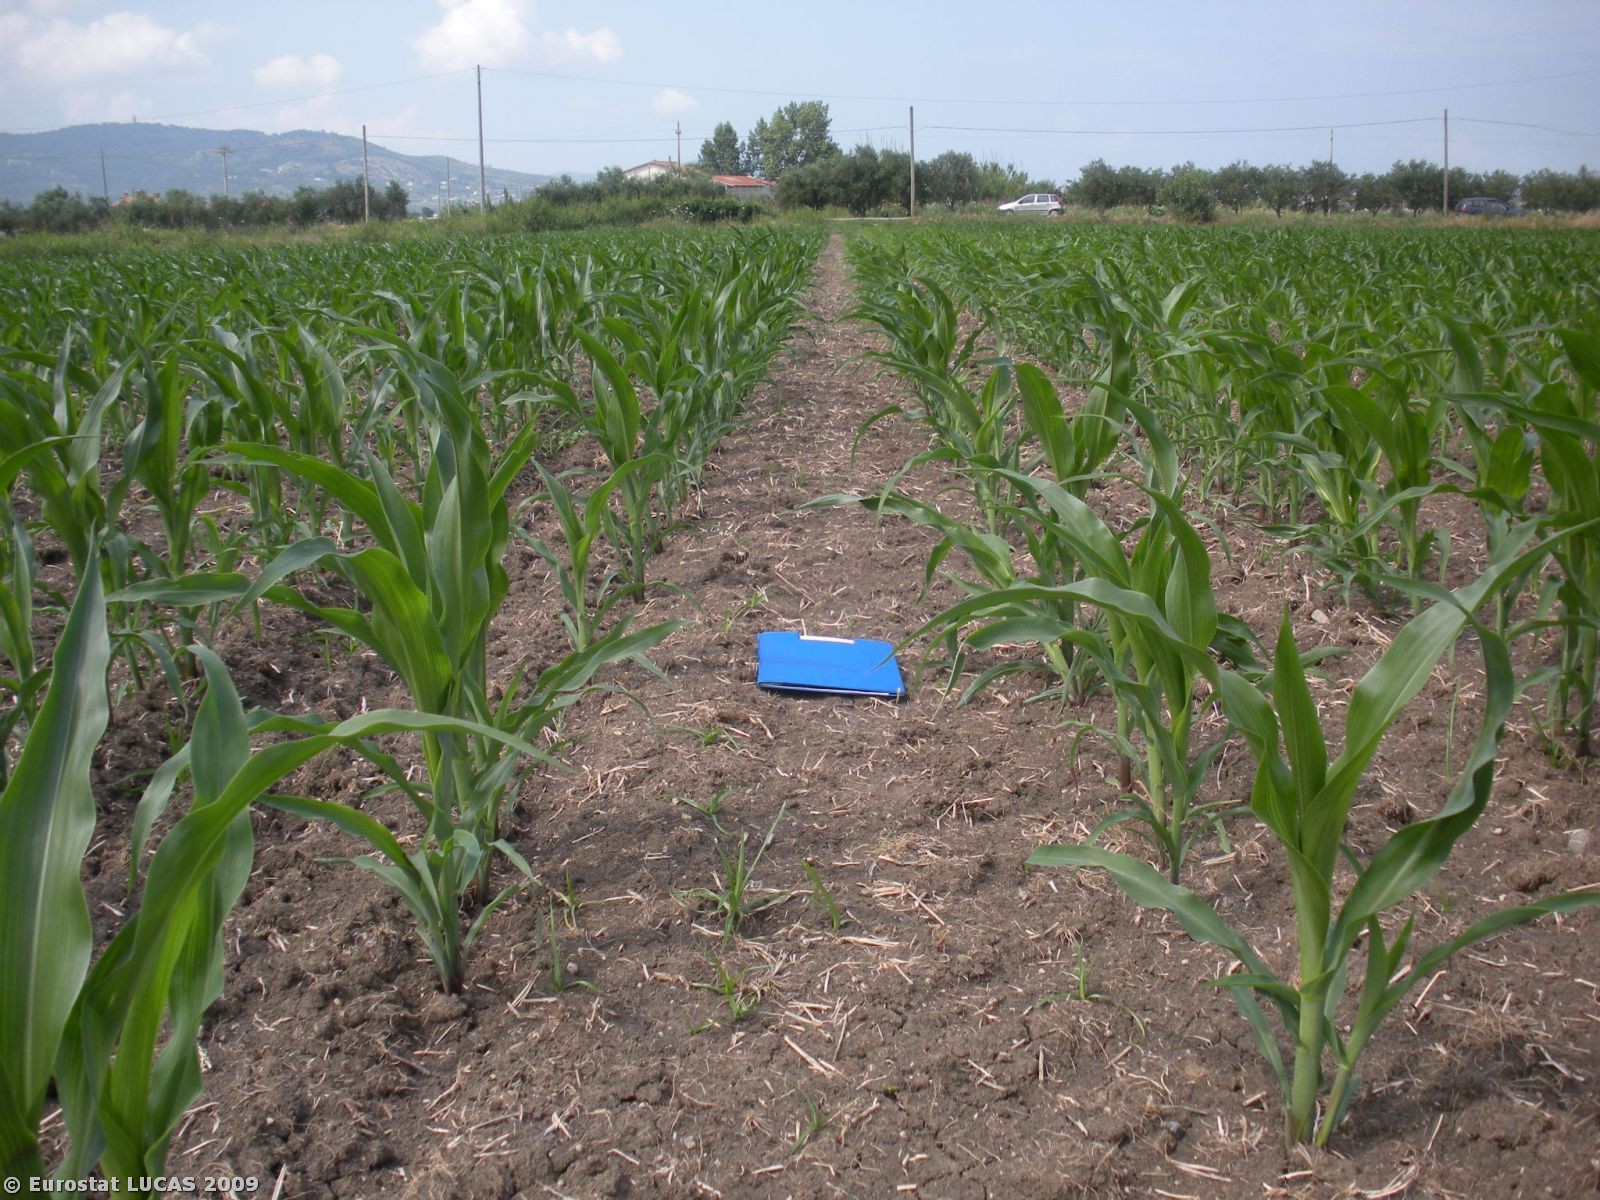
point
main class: Cropland
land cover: Maize
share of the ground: 25 - 50 %
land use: Agriculture (excluding fallow land and kitchen gardens)
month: July
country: IT
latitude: 40.4100
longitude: 15.0336
